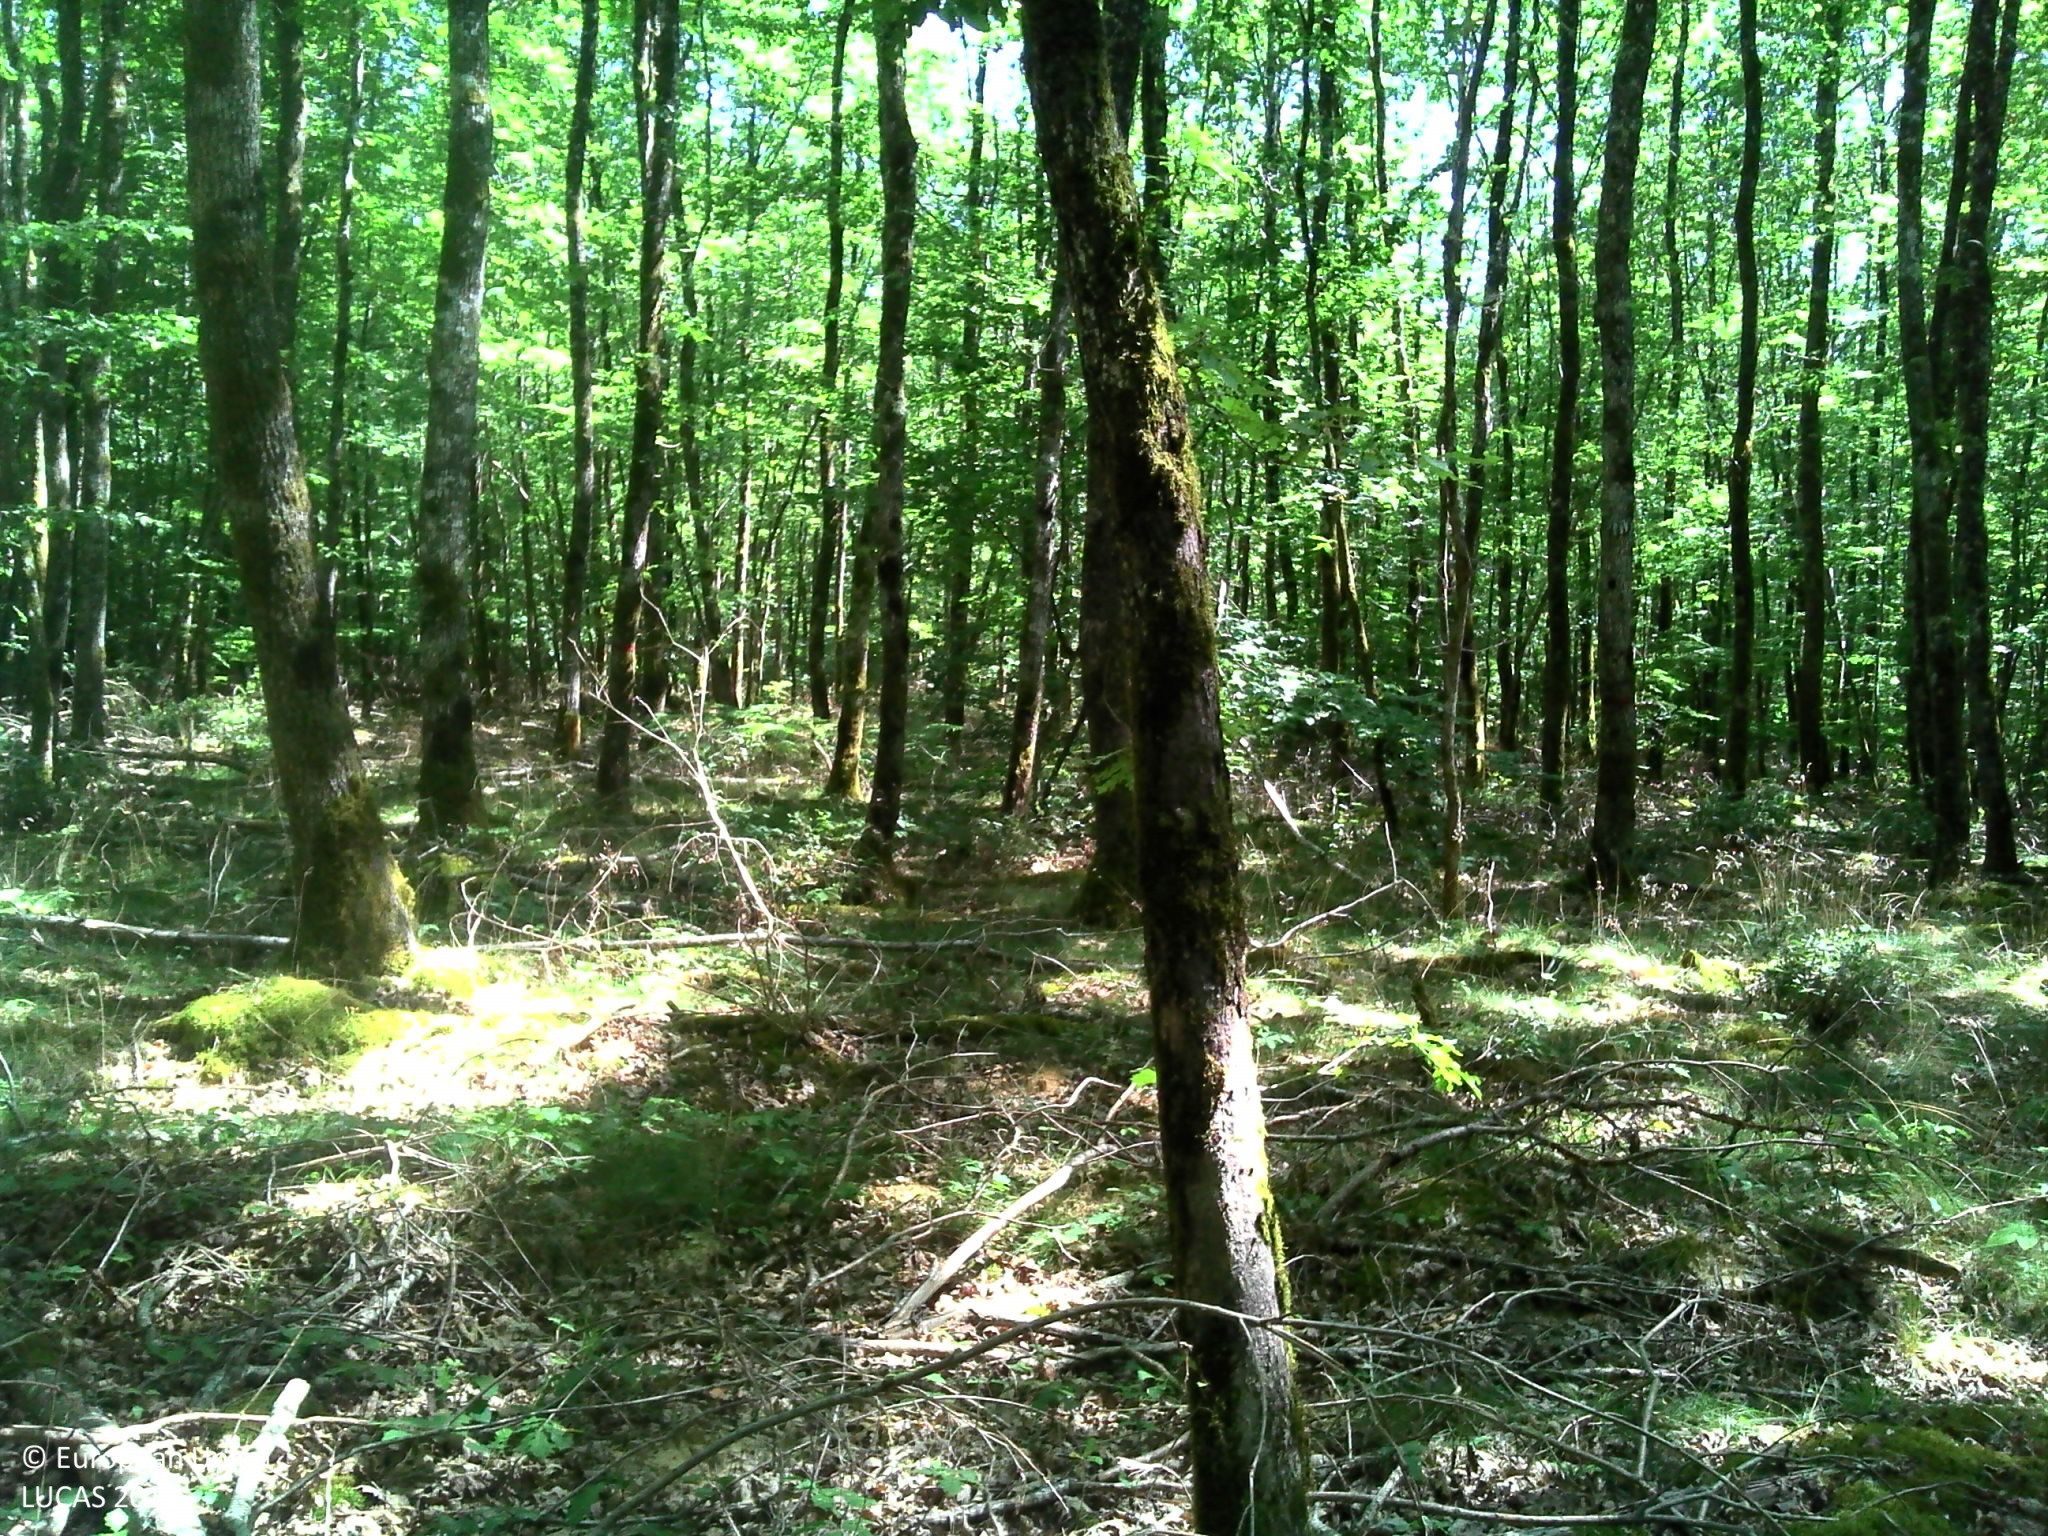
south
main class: Woodland
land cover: Broadleaved woodland
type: mesophytic deciduous forest
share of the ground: > 75 %
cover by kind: broadleaved forest trees 100 %
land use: Forestry
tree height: > 5 m
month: July
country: FR
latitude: 47.0948
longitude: 3.2378
